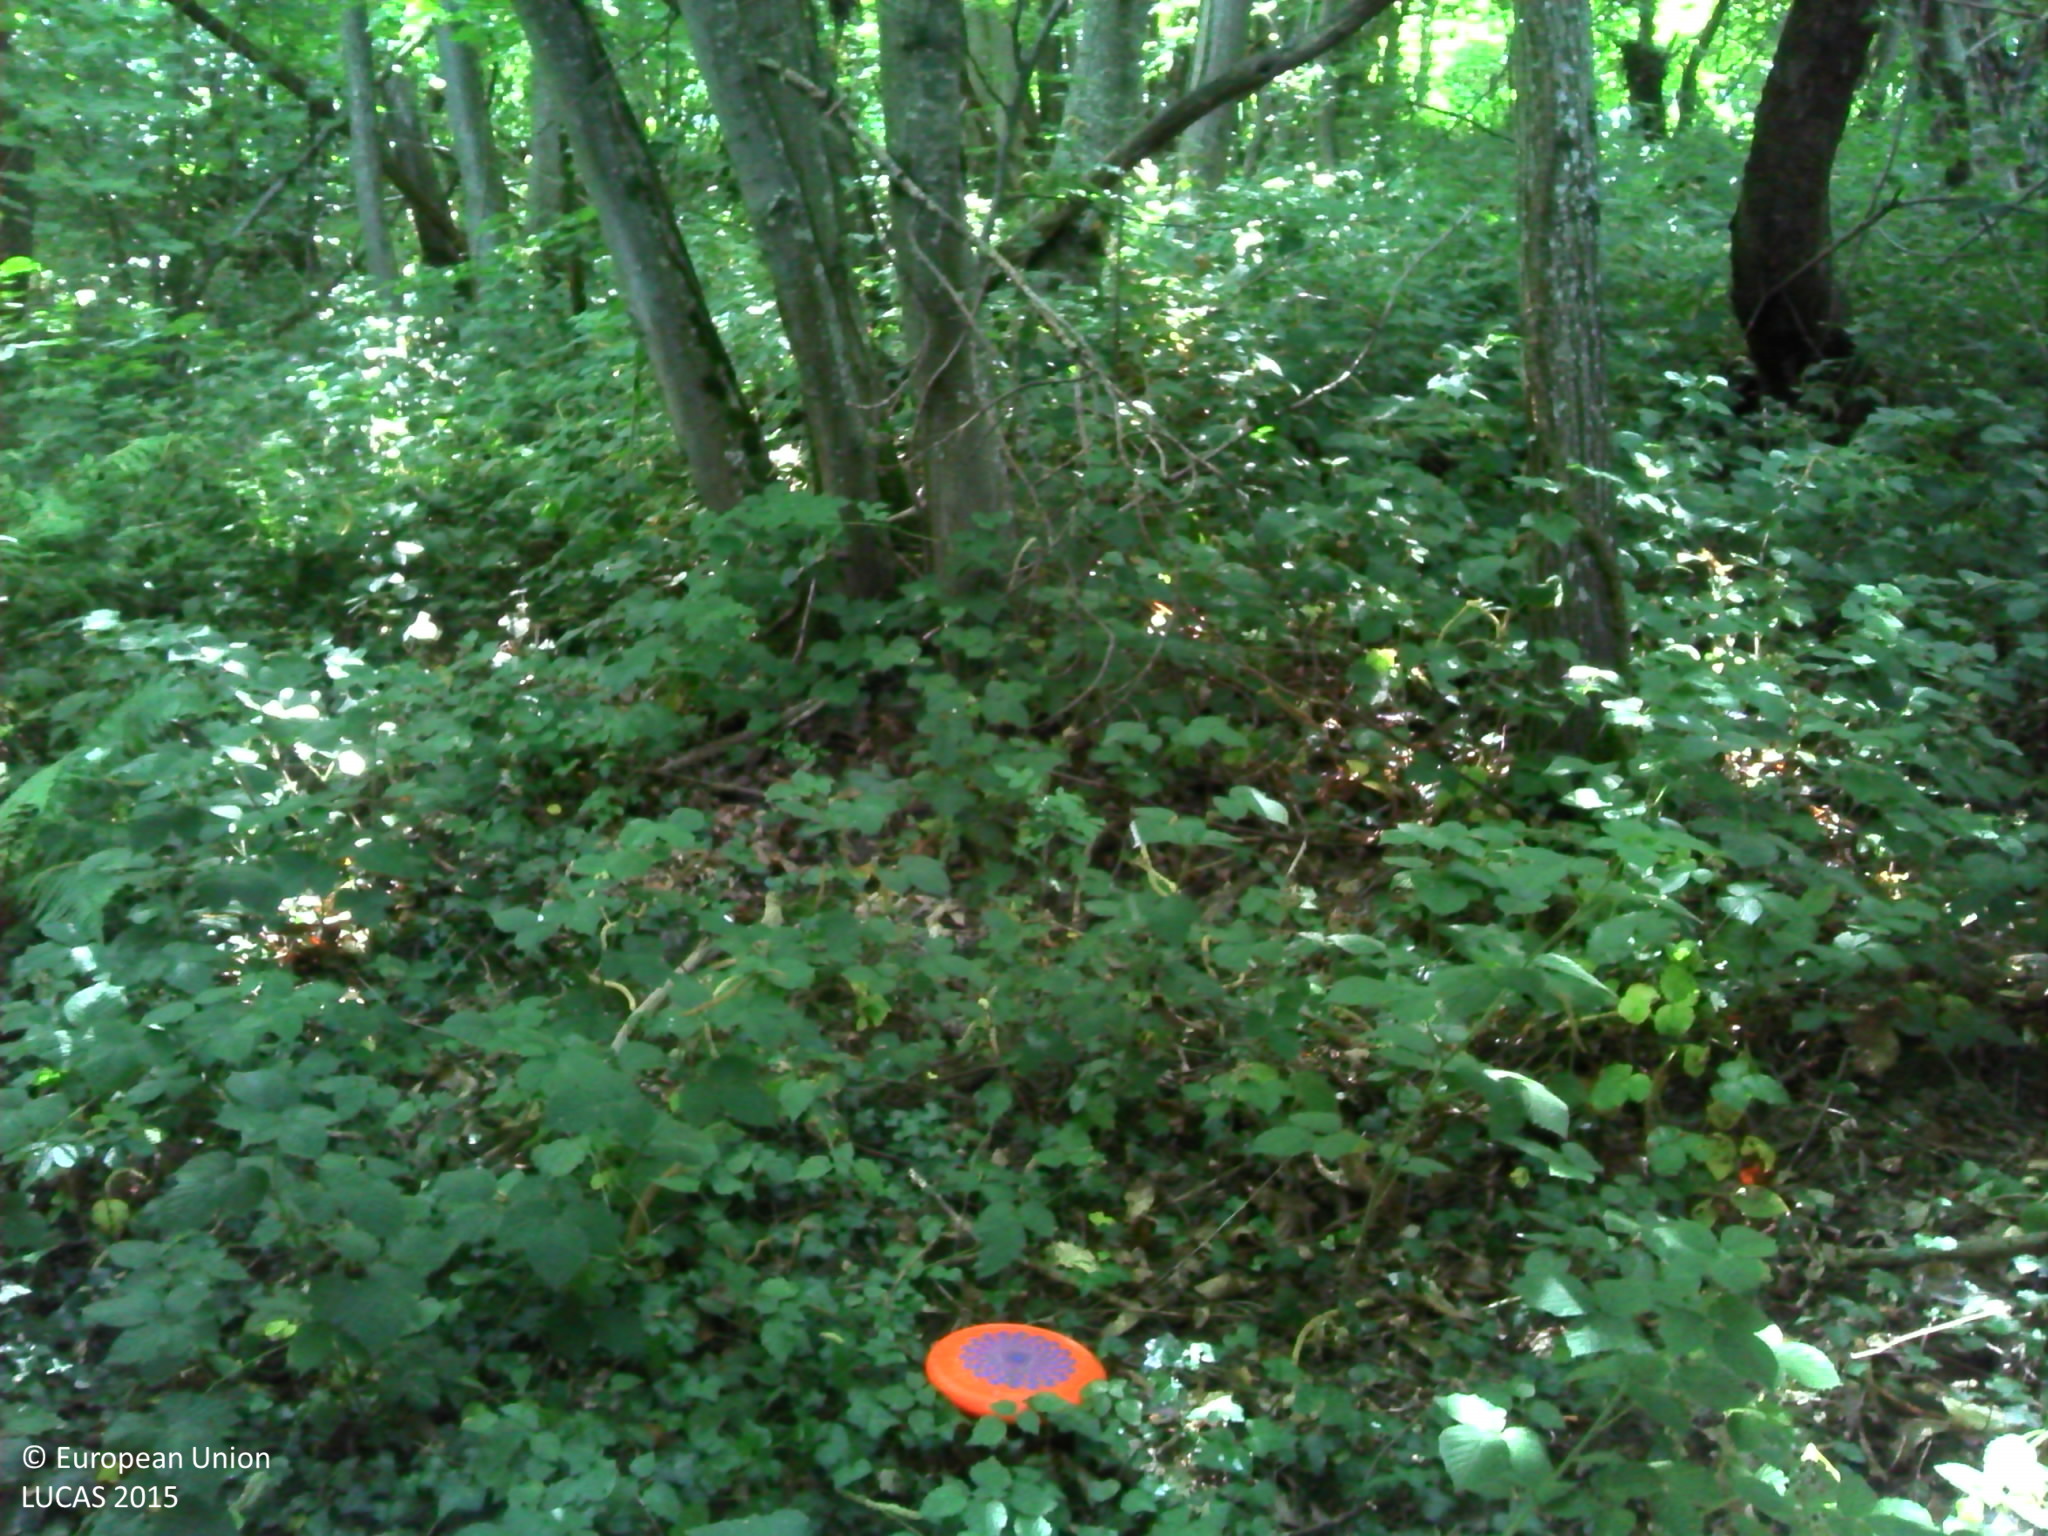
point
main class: Woodland
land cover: Broadleaved woodland
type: thermophilous deciduous forest
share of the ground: > 75 %
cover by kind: broadleaved forest trees 65 %, herbaceous plants 30 %, lichens and mosses 5 %
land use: Forestry
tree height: > 5 m
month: July
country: FR
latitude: 45.4993
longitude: 5.5127
